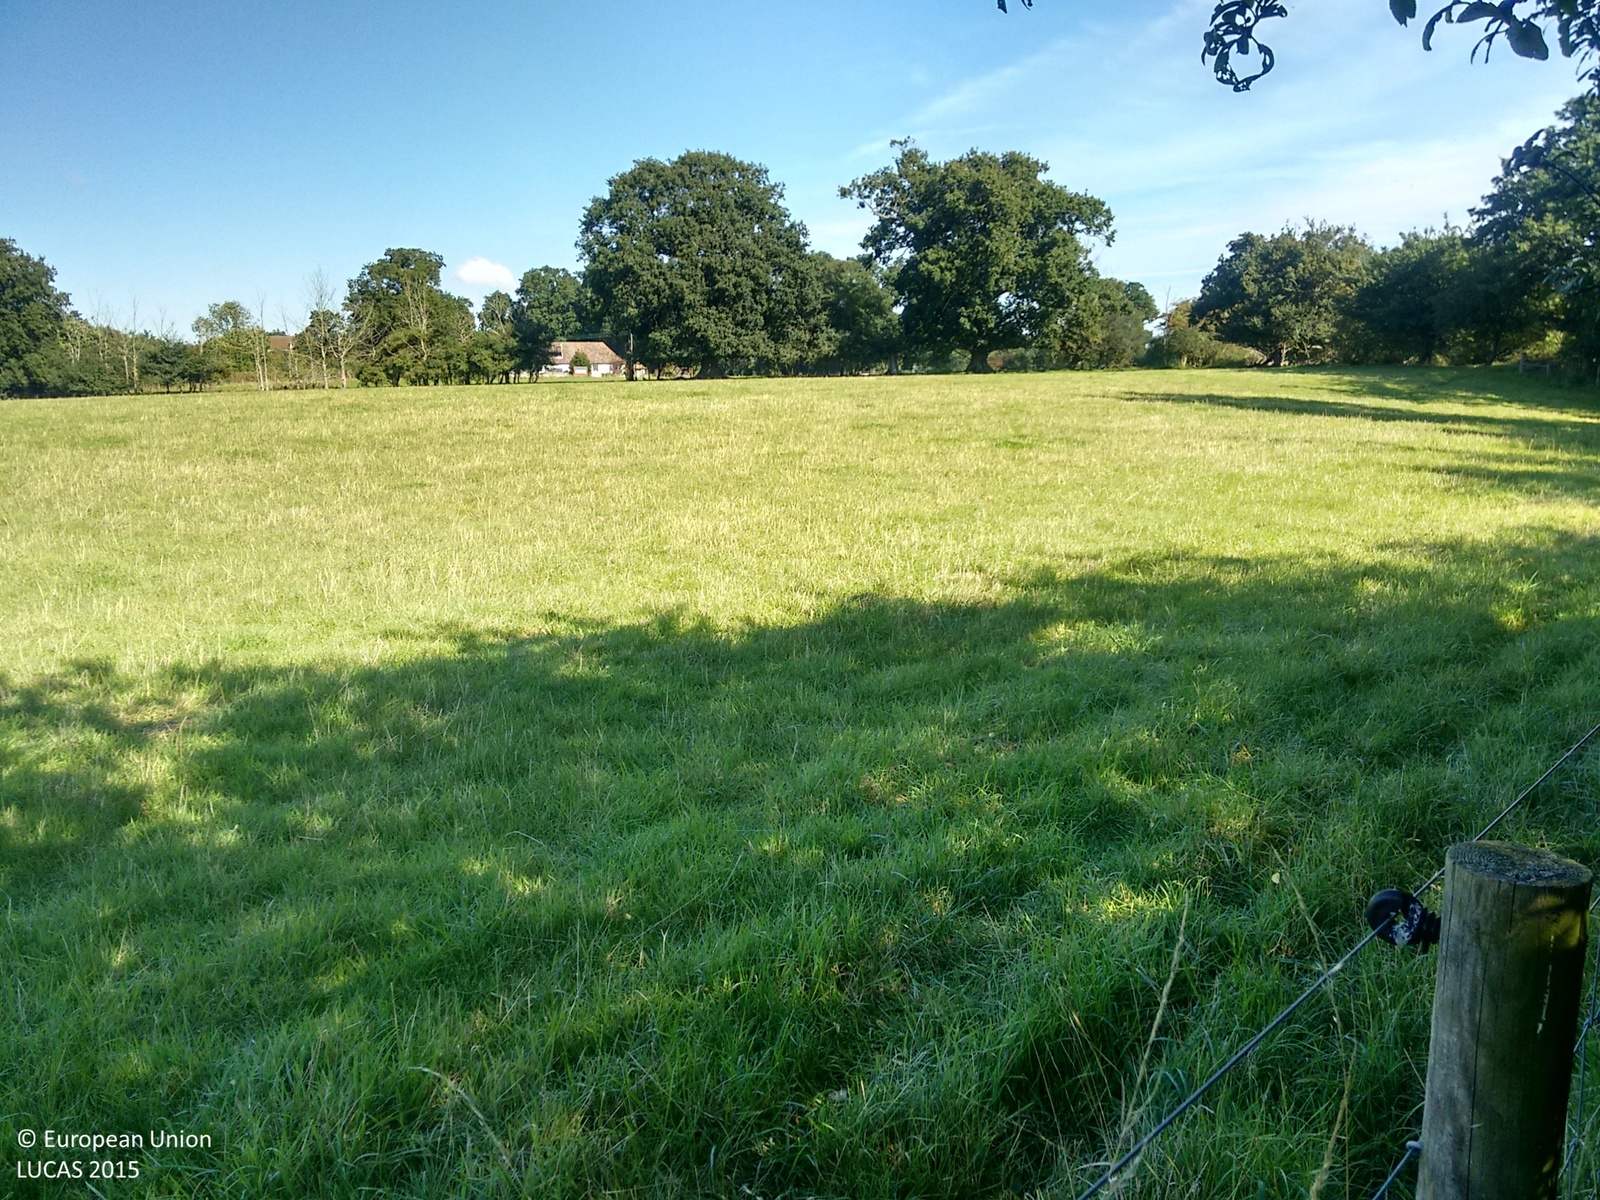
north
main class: Grassland
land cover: Grassland without tree/shrub cover
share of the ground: > 75 %
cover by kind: herbaceous plants 100 %
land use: Agriculture (excluding fallow land and kitchen gardens)
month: September
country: GB
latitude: 52.1753
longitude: 1.4257
